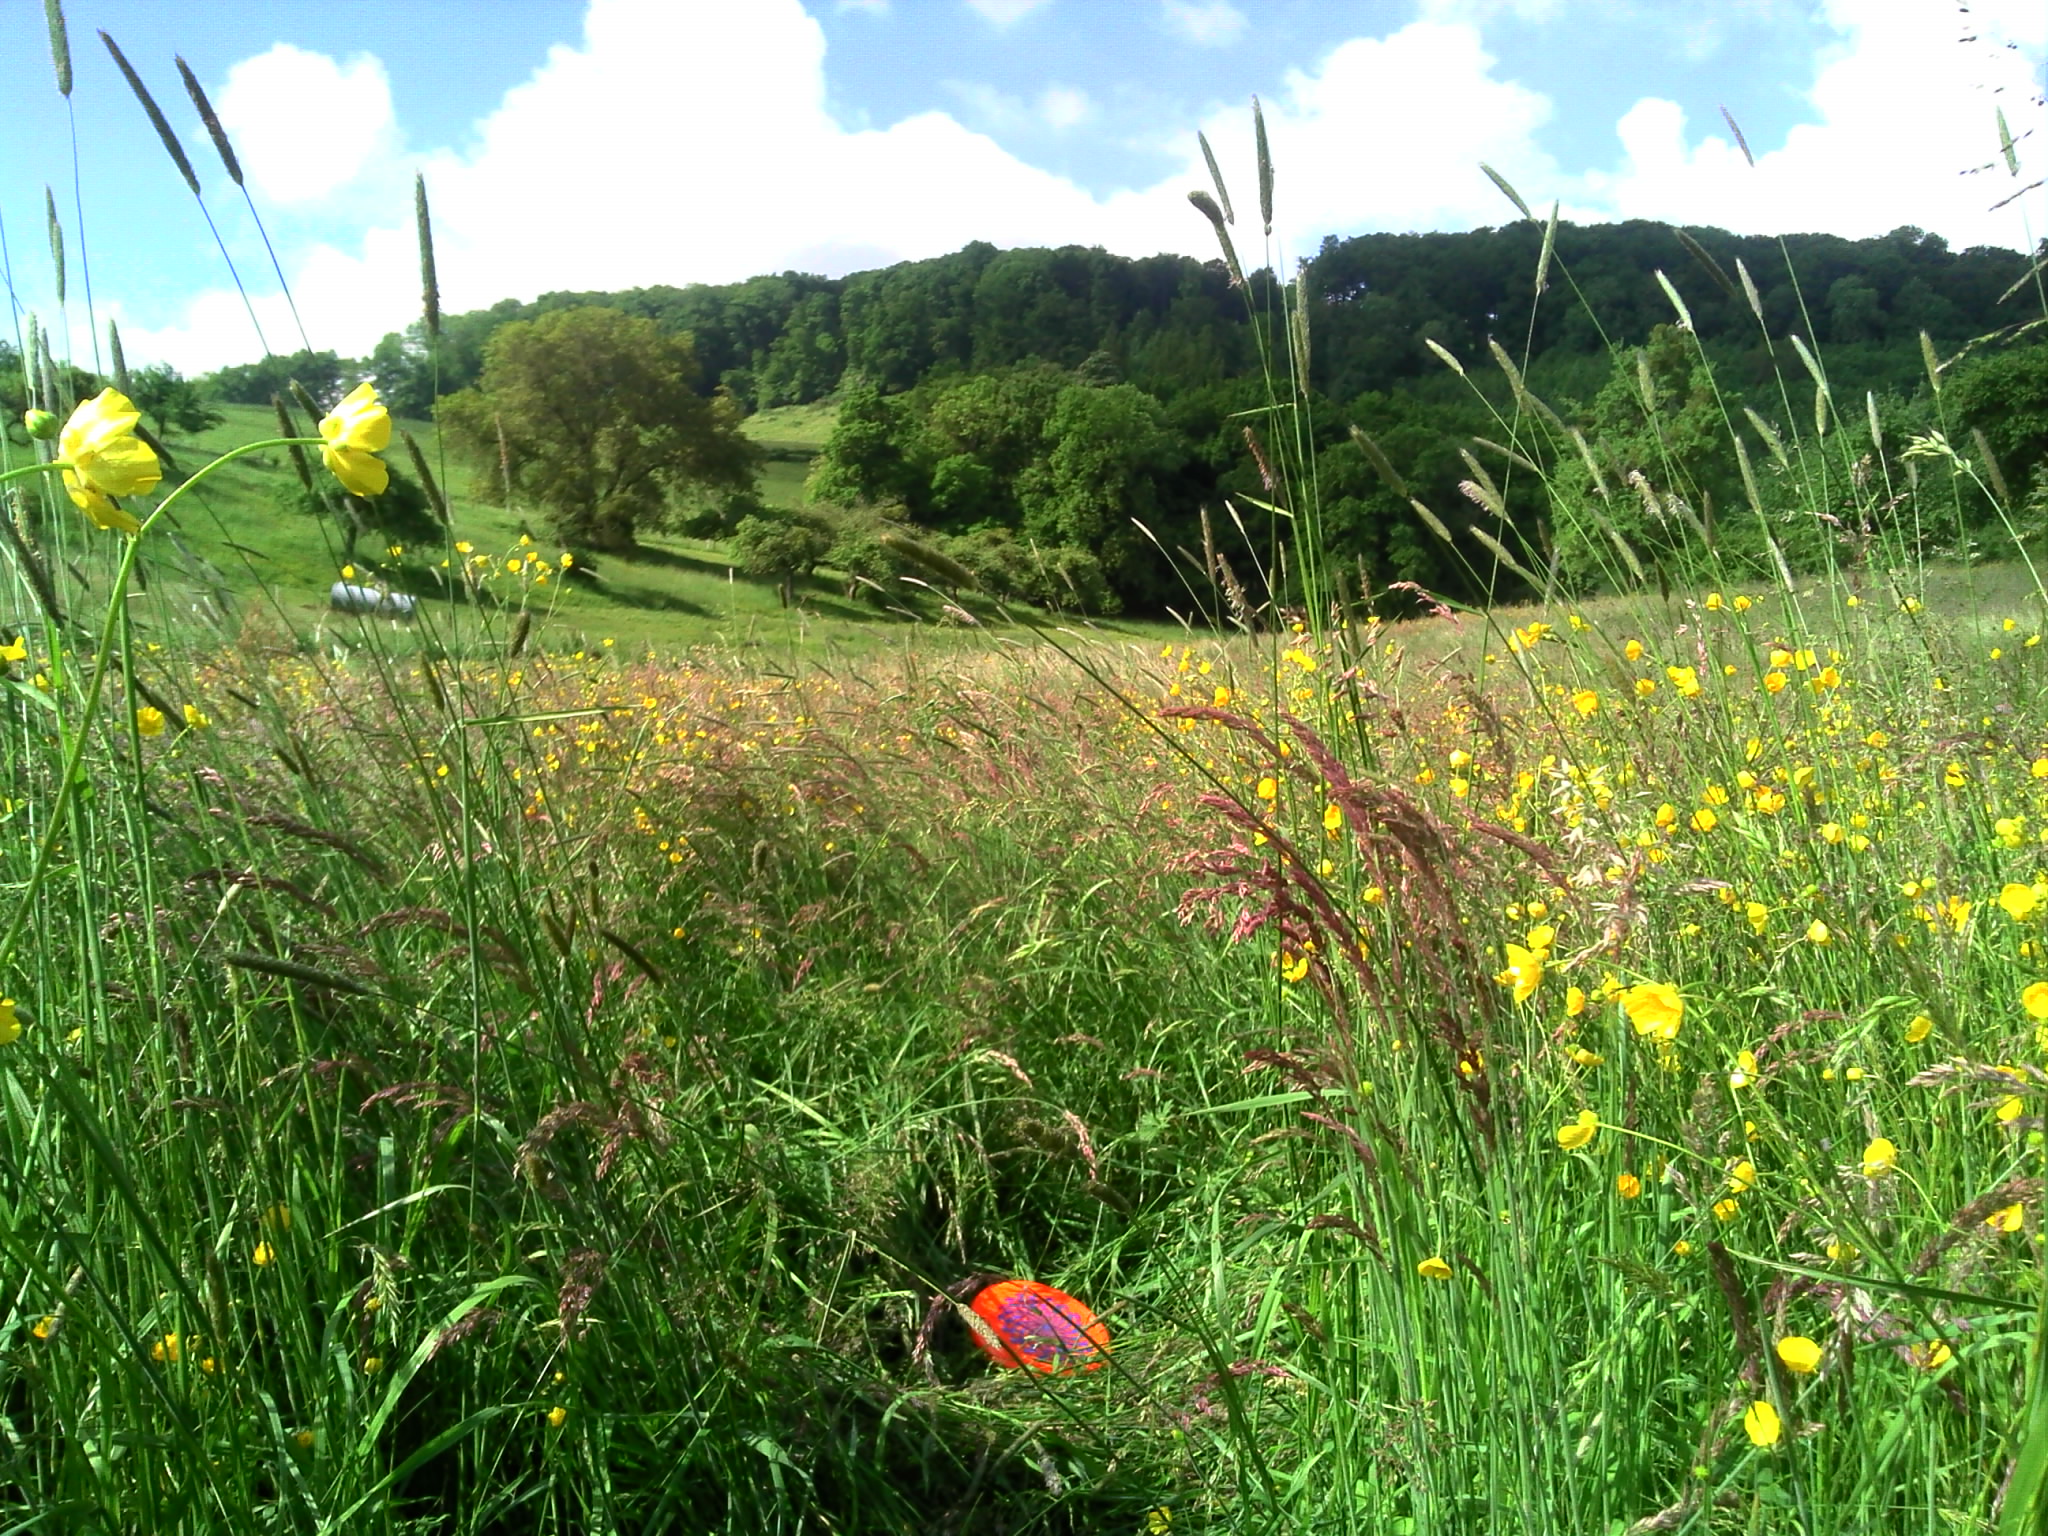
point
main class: Grassland
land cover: Grassland without tree/shrub cover
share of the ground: > 75 %
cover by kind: herbaceous plants 100 %
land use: Agriculture (excluding fallow land and kitchen gardens)
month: May
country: LU
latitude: 49.5655
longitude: 6.2803
